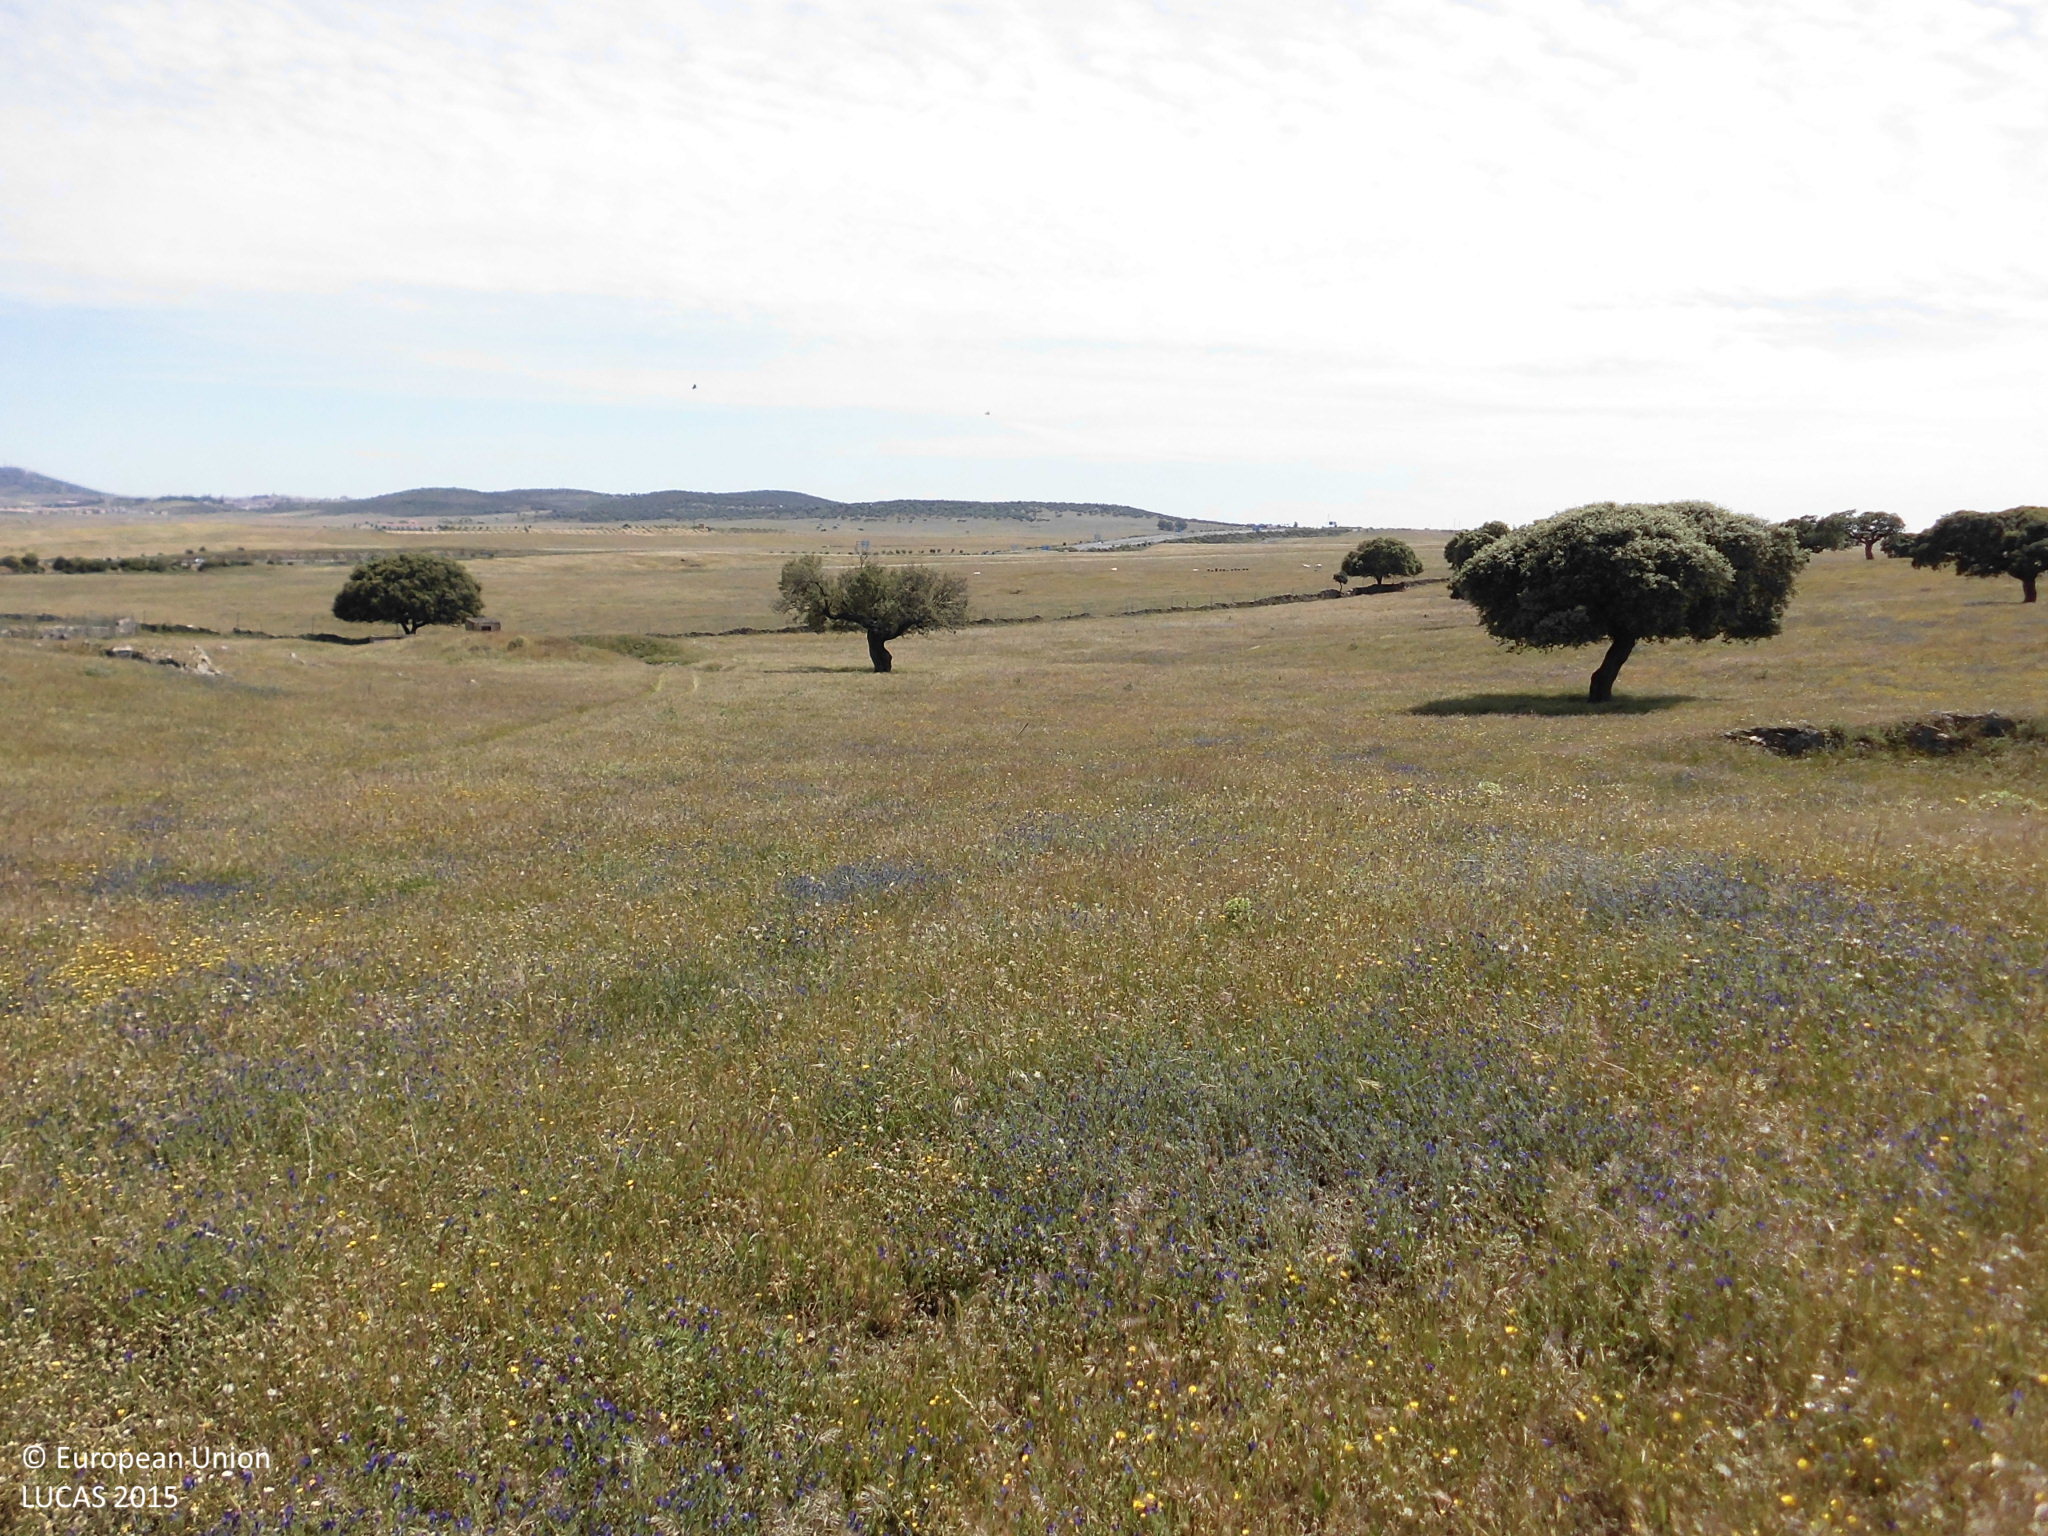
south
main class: Grassland
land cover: Grassland without tree/shrub cover
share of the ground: > 75 %
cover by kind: herbaceous plants 100 %
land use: Agriculture (excluding fallow land and kitchen gardens)
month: May
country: ES
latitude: 39.5368
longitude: -6.4172
